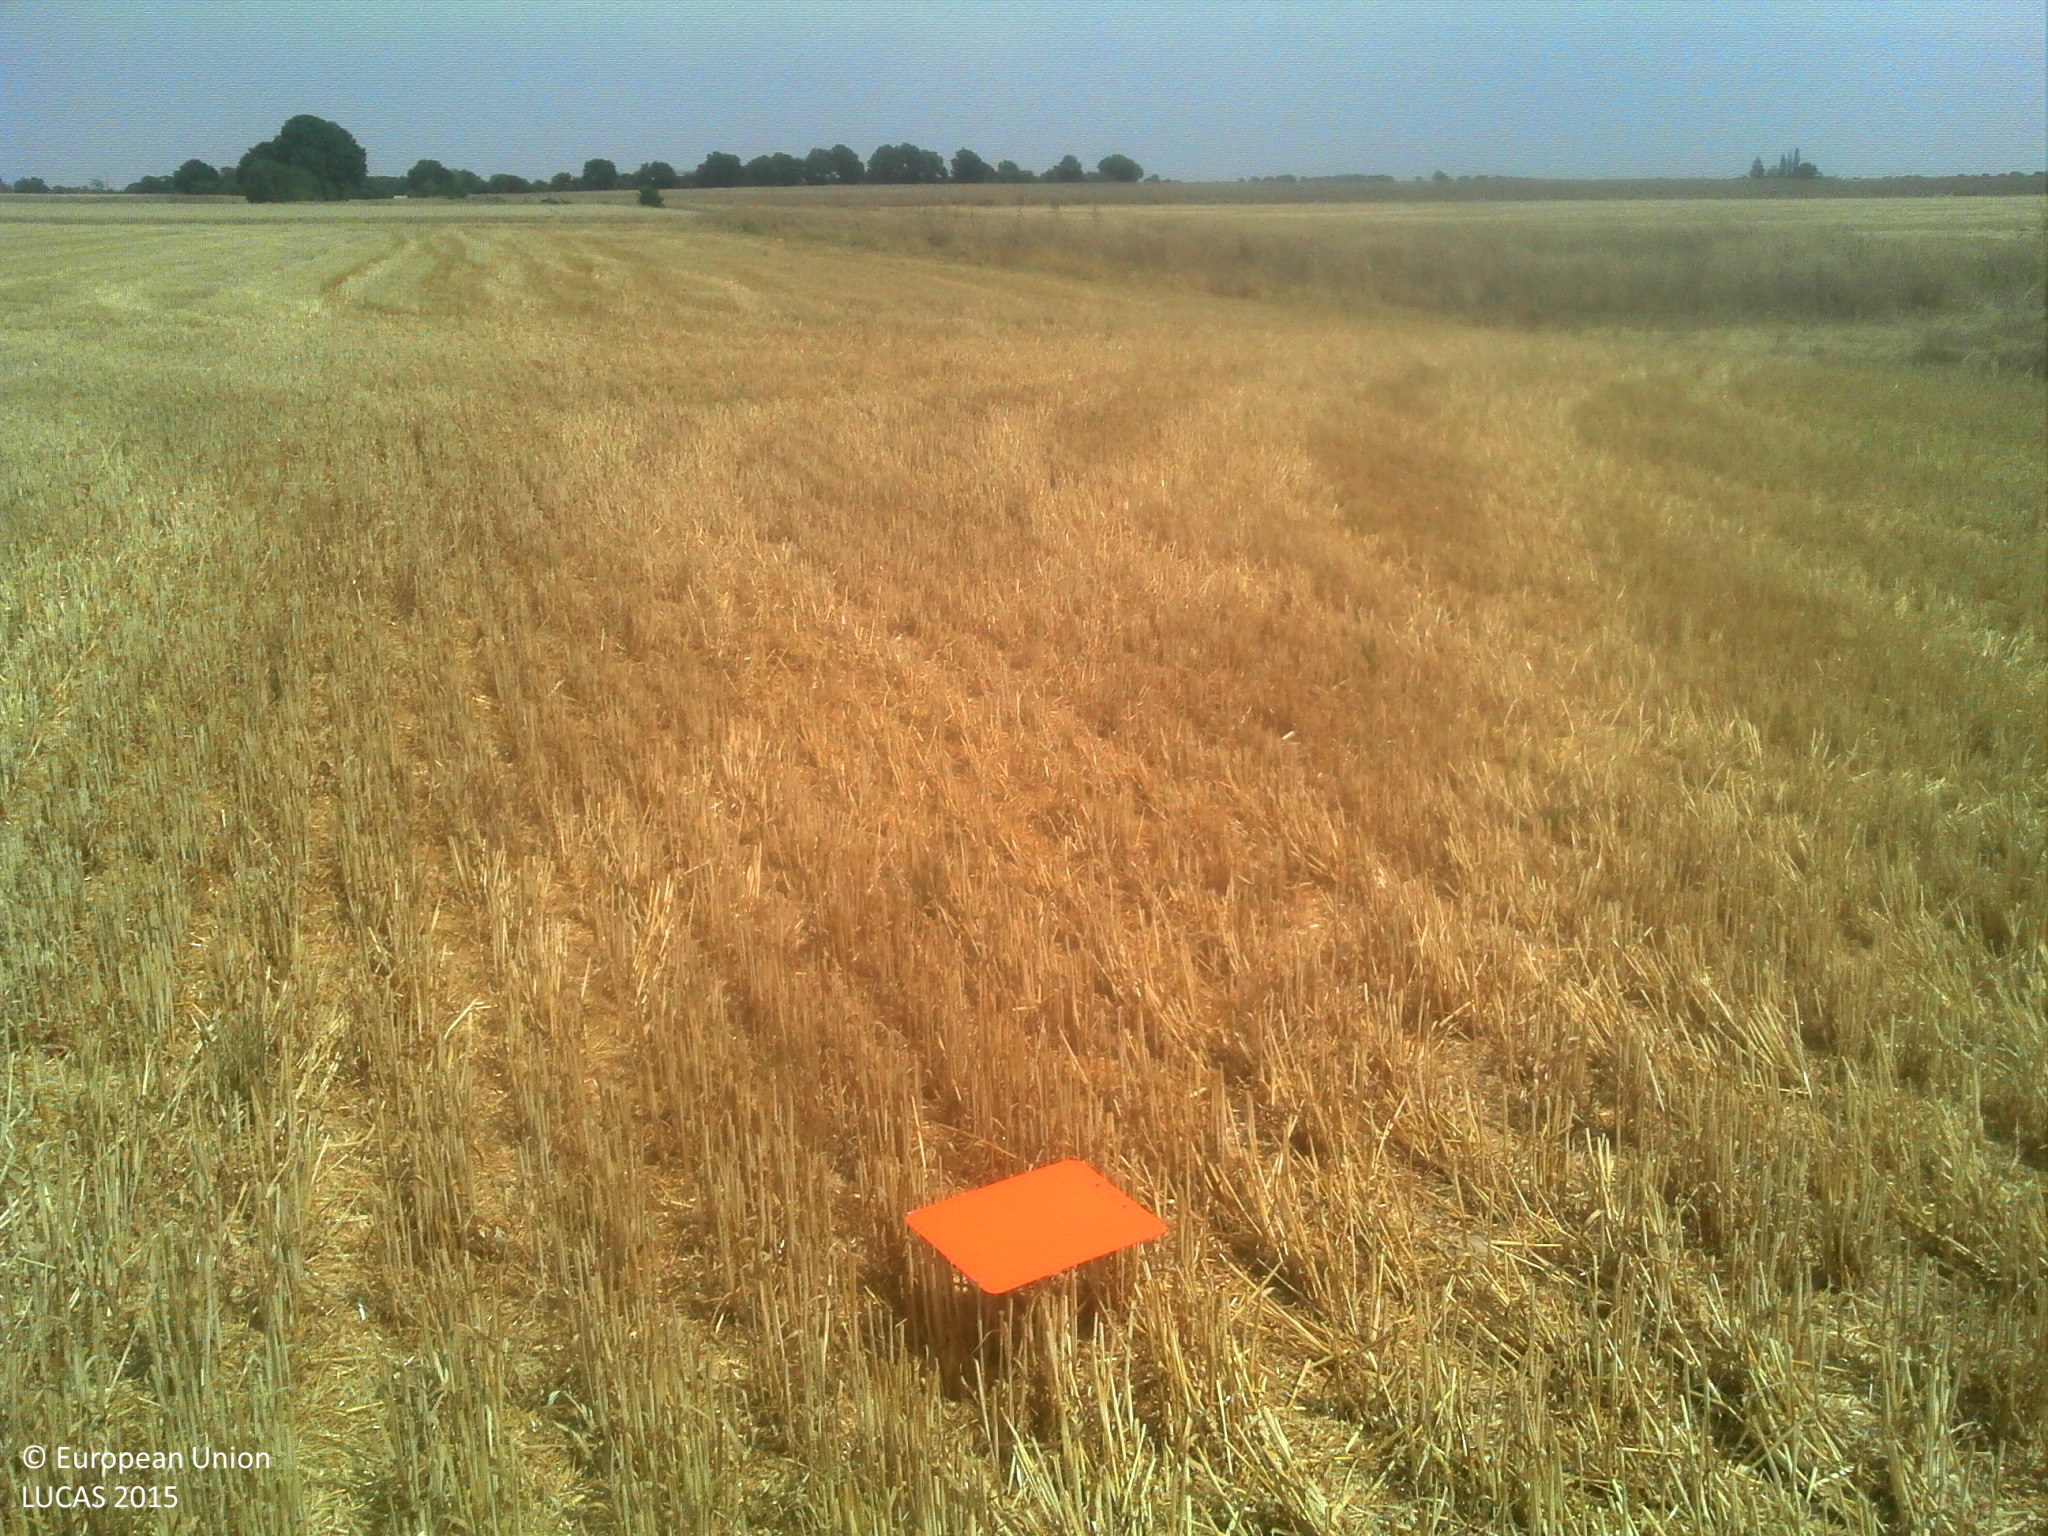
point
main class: Cropland
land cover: Barley
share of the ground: > 75 %
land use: Agriculture (excluding fallow land and kitchen gardens)
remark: Harvested field
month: July
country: FR
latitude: 48.0609
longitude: 1.0849
